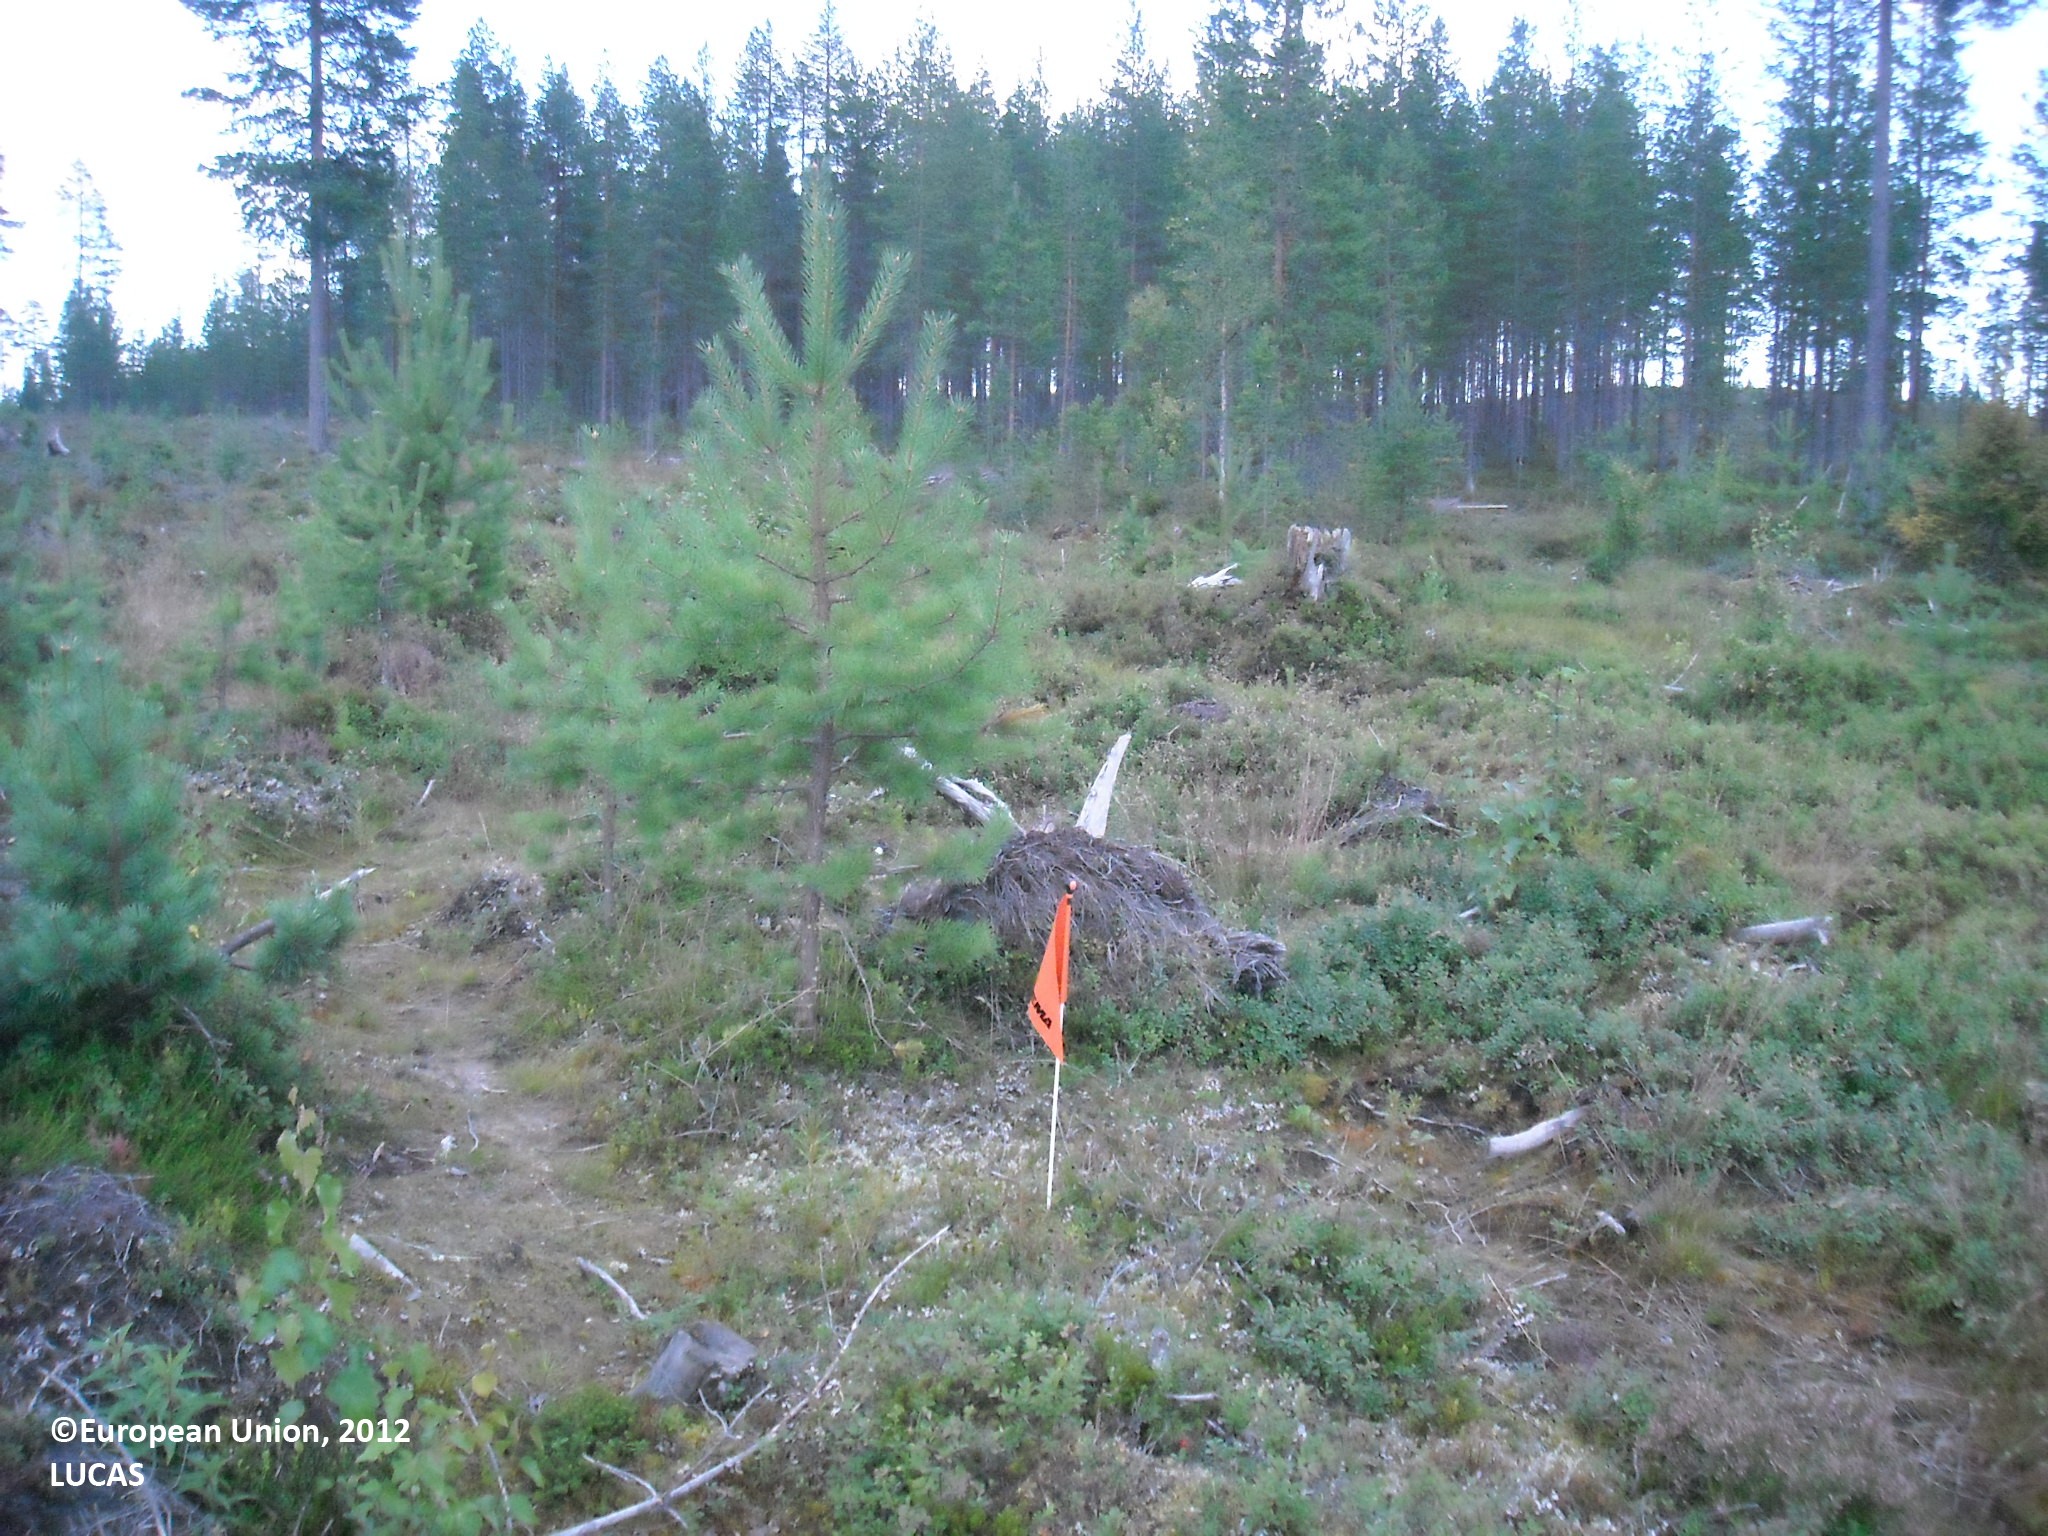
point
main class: Shrubland
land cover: Shrubland with sparse tree cover
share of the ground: > 75 %
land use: Forestry
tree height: > 5 m
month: August
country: FI
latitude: 65.1950
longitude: 27.7217
